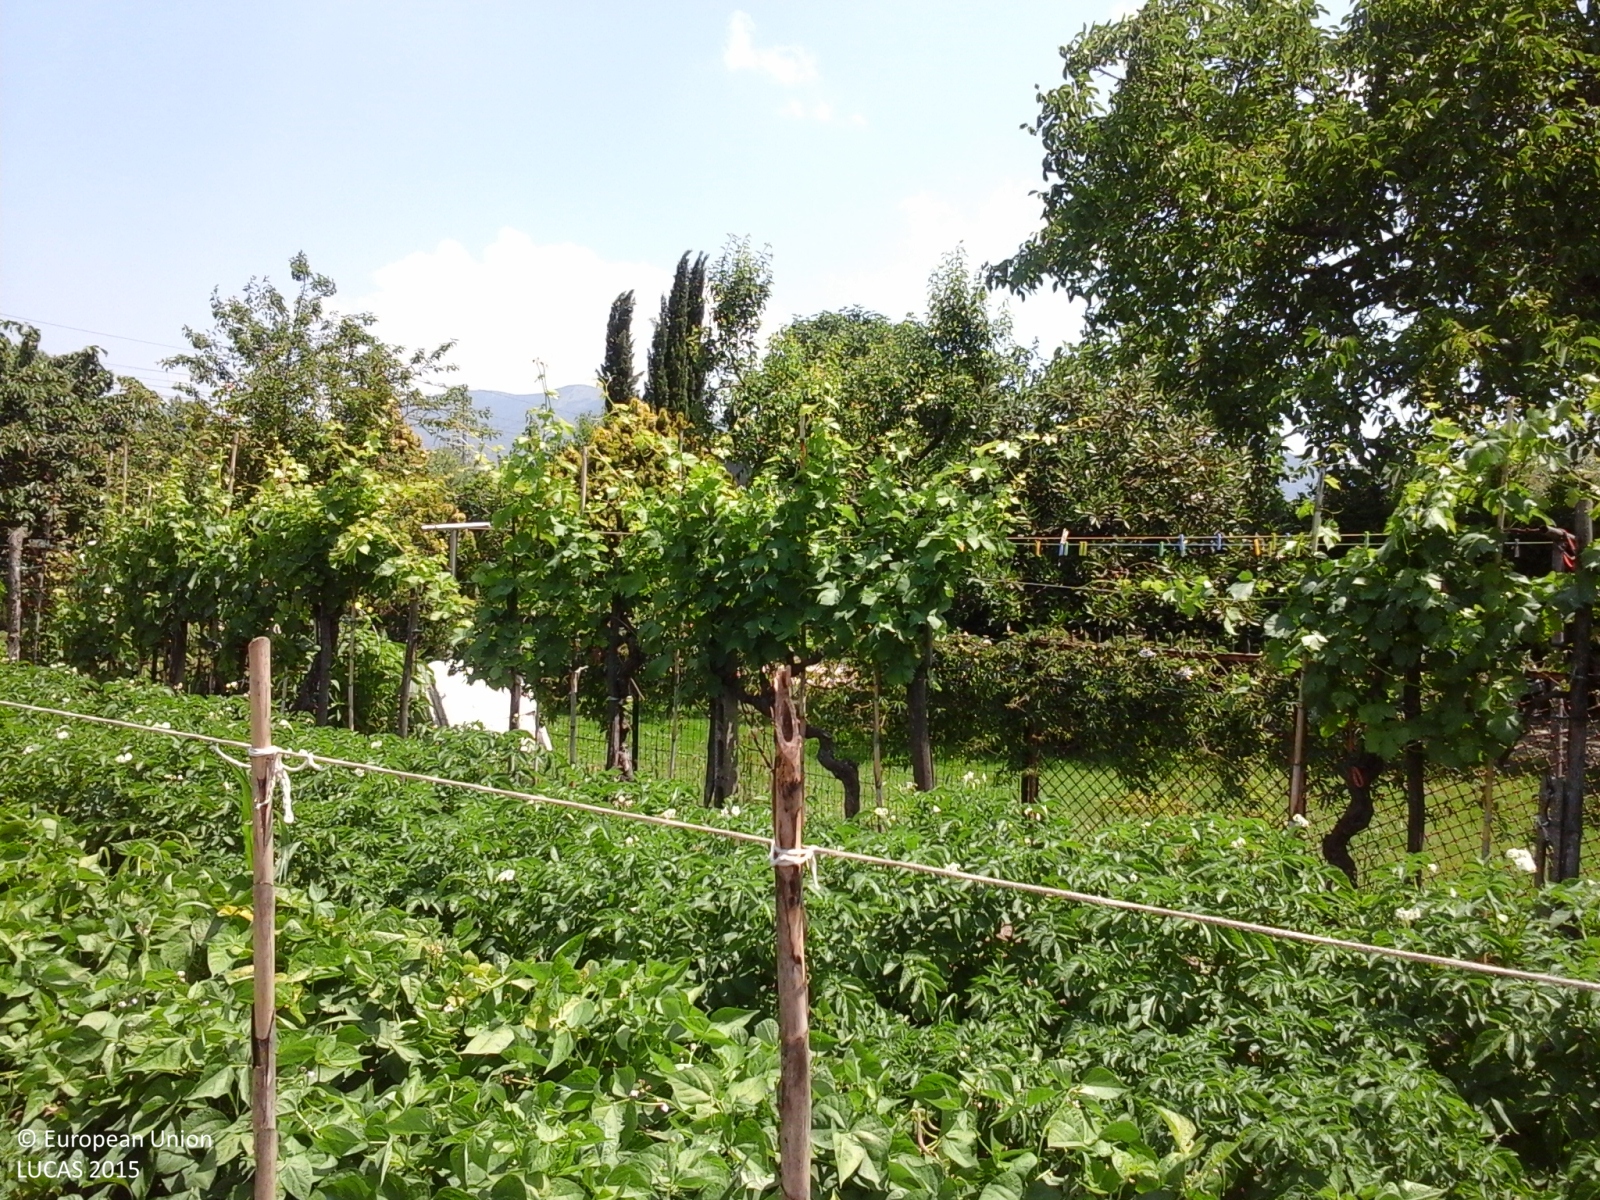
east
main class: Cropland
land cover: Other fresh vegetables
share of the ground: > 75 %
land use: Kitchen garden
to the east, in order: Other fresh vegetables; Tomatoes; Potatoes; Vineyards; Fences; Tracks; Managed hedges; Artificial constructions; Paved roads, cycling and walking lanes; Vineyards; Grassland without tree/shrub cover; Olive groves; Vineyards; Other bare soil; Grassland with sparse tree/shrub cover; Railways; Grassland with sparse tree/shrub cover
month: June
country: IT
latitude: 43.8942
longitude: 11.0555
